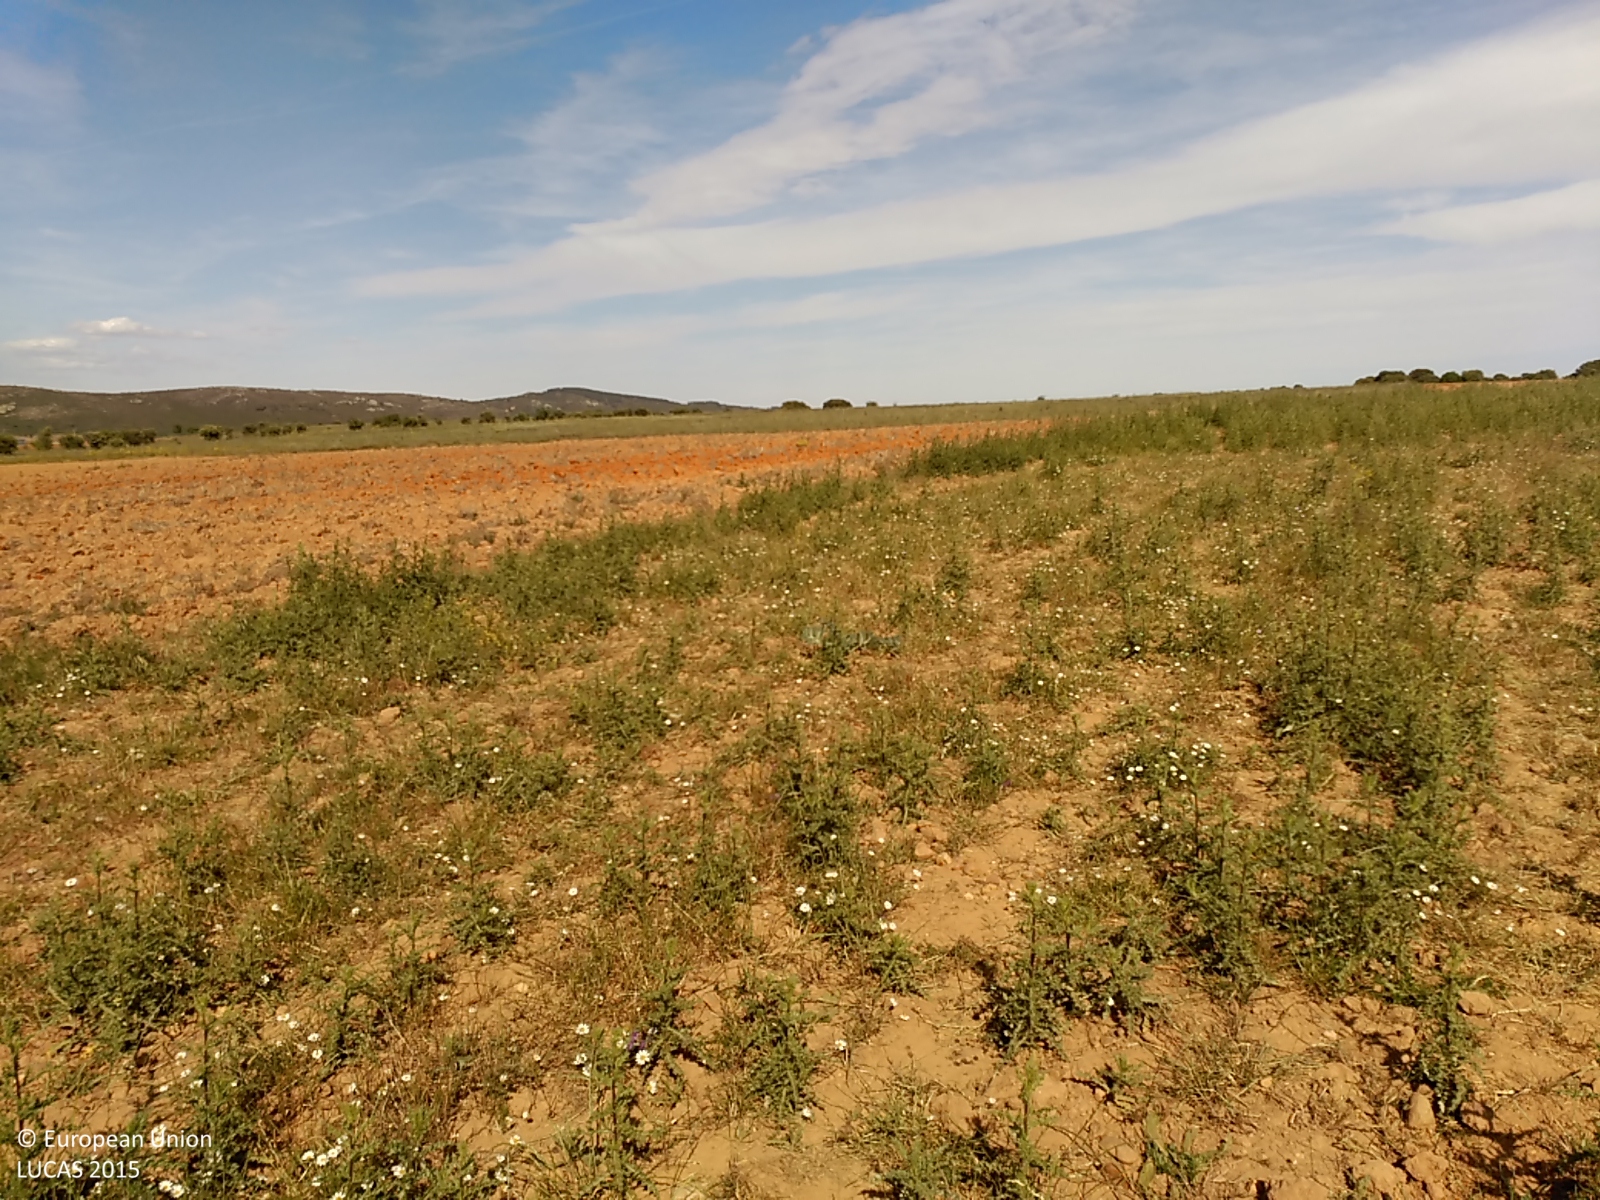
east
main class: Grassland
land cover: Spontaneously vegetated surfaces
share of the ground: > 75 %
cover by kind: herbaceous plants 80 %, unconsolidated bare surface 20 %
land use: Fallow land
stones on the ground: 10 - 25 %
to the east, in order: Spontaneously vegetated surfaces; Other bare soil; Grassland without tree/shrub cover
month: May
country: ES
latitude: 42.0442
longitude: -5.9362
